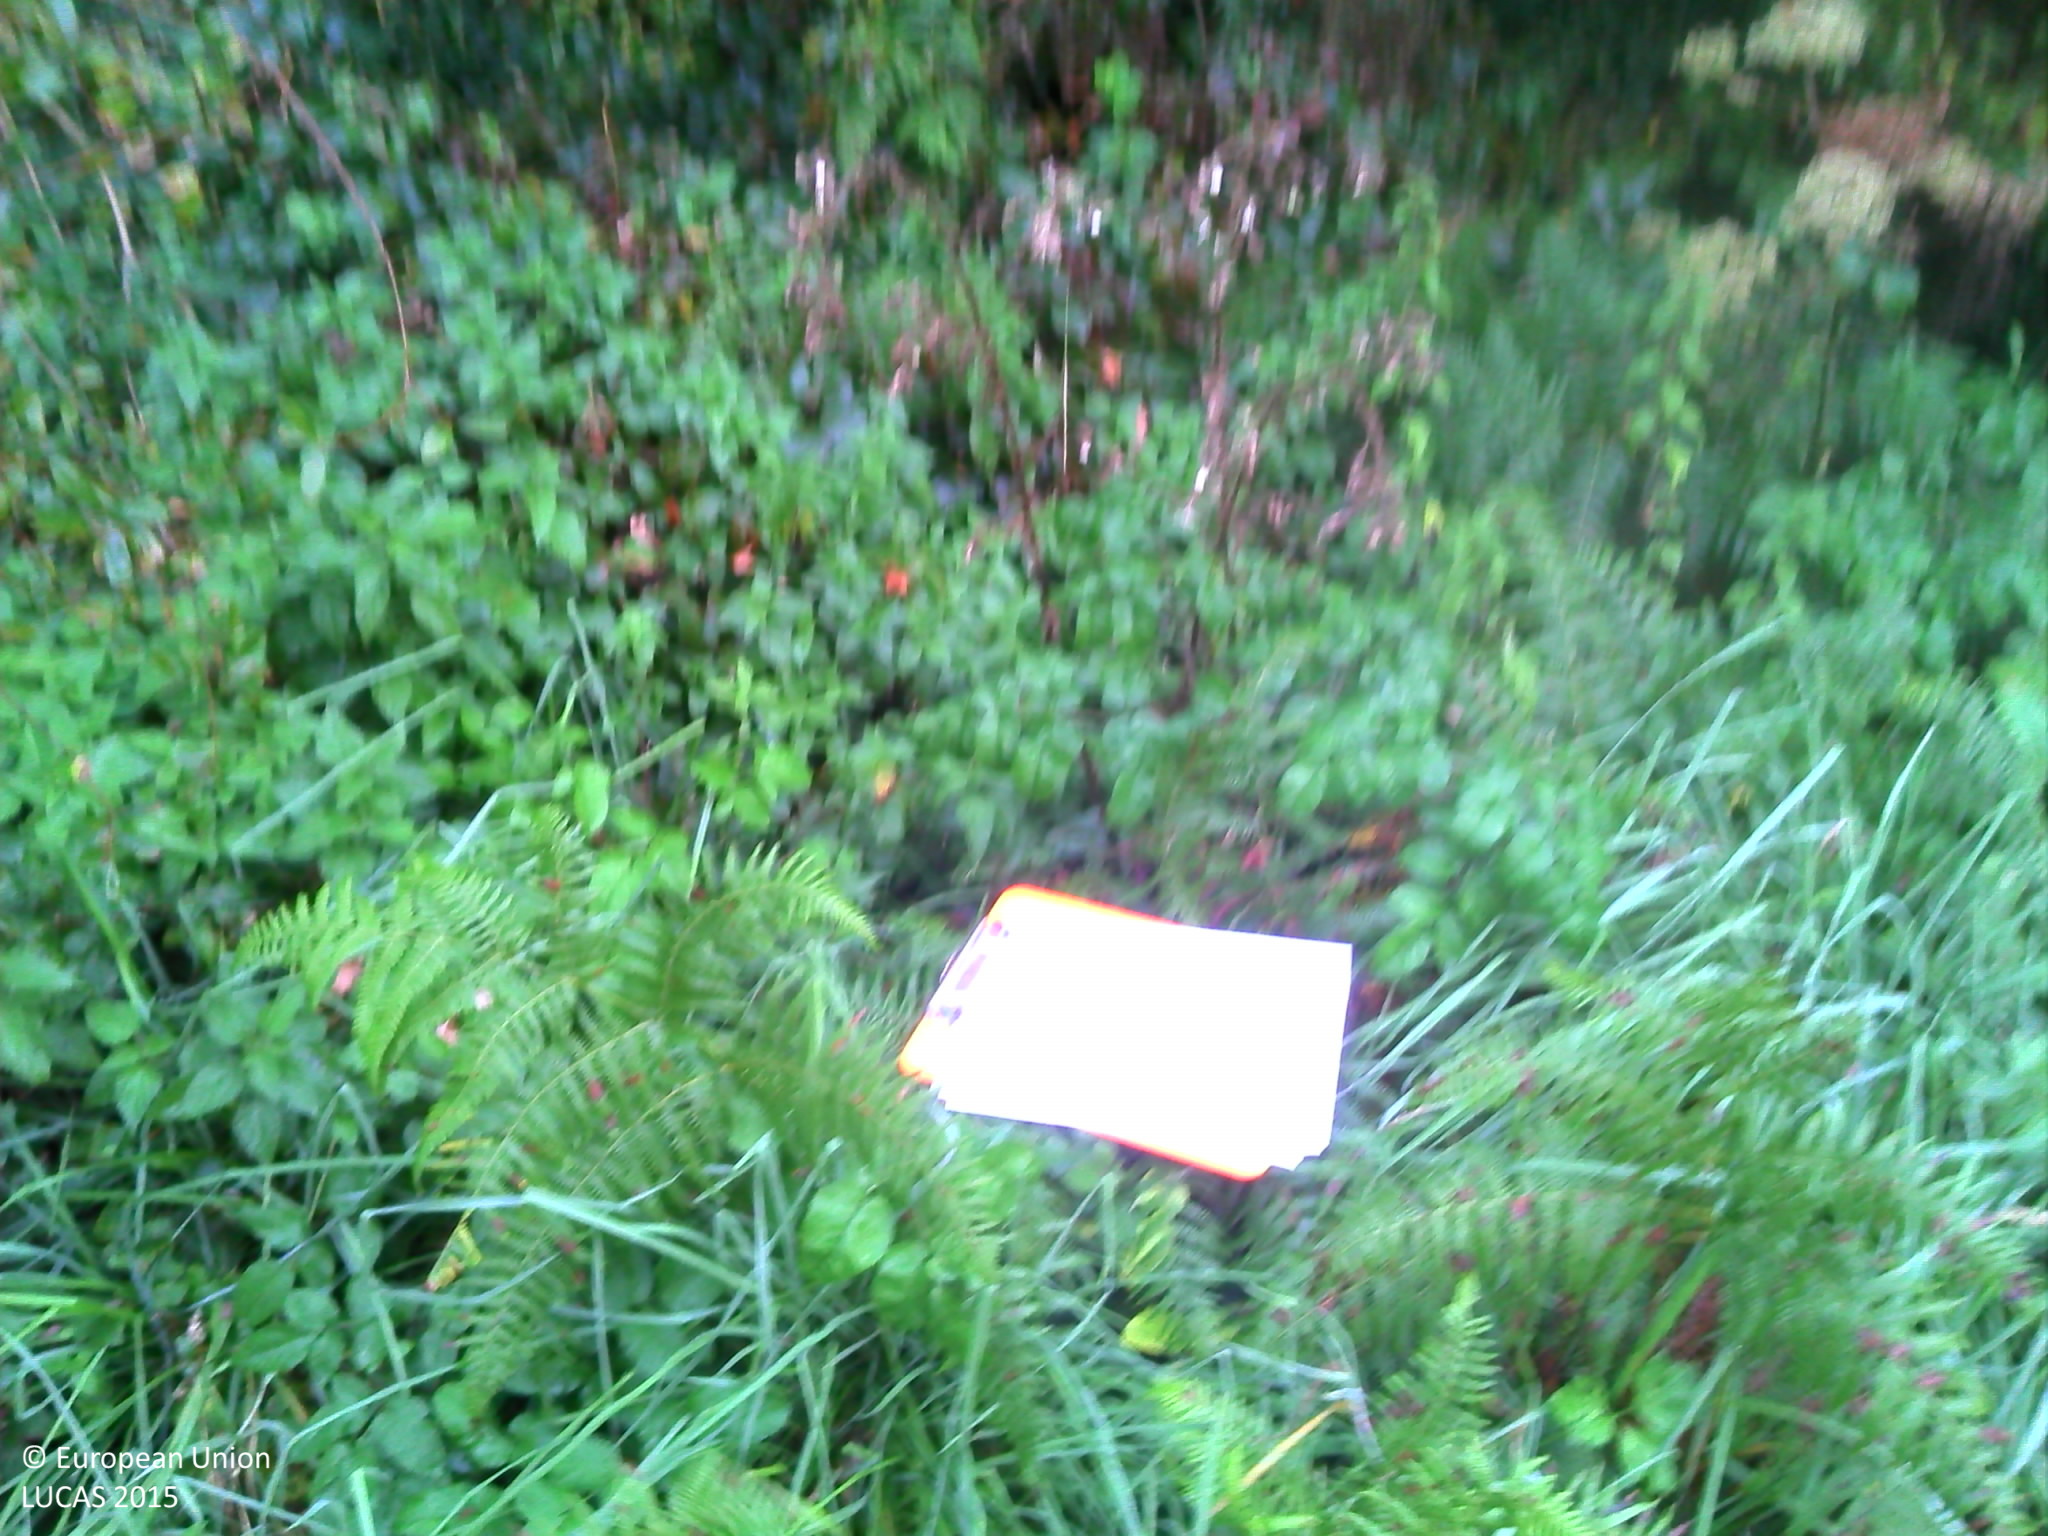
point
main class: Grassland
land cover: Spontaneously vegetated surfaces
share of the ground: > 75 %
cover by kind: herbaceous plants 95 %, shrubs 5 %
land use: Semi-natural and natural areas not in use
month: October
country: FR
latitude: 47.6600
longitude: -2.2917
